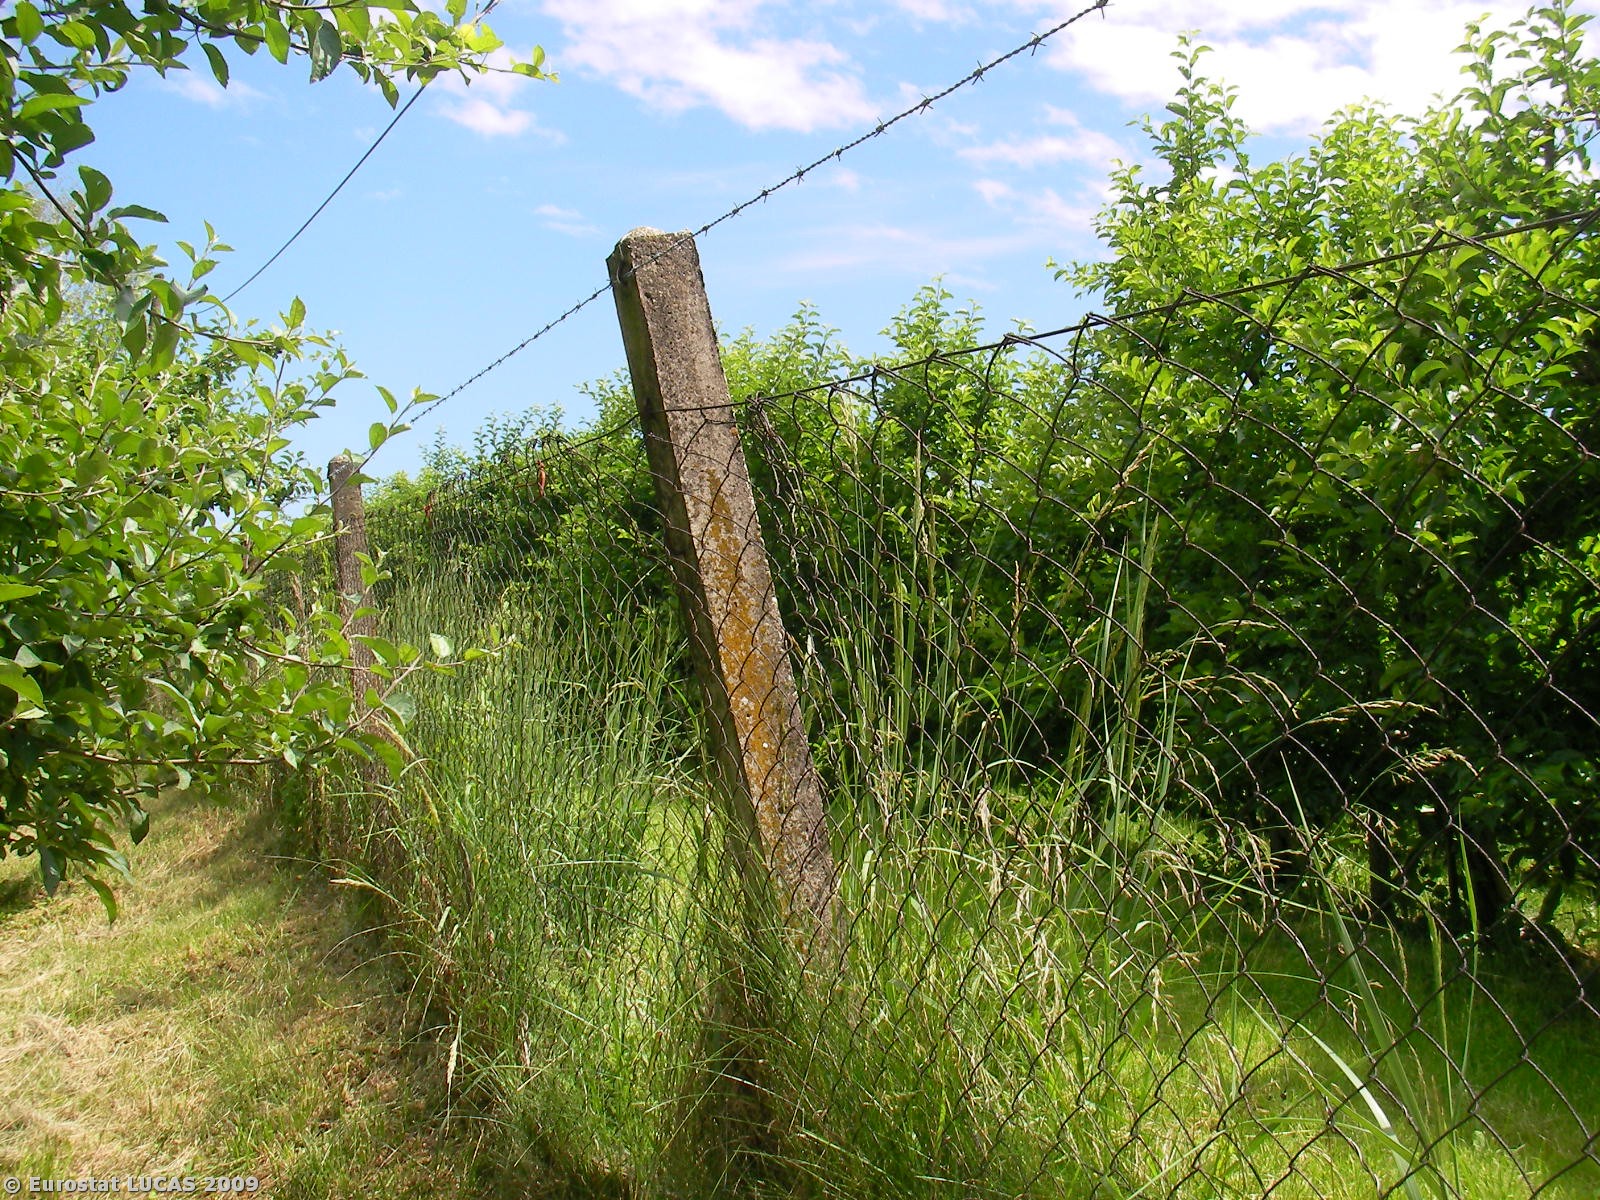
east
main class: Cropland
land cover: Apple fruit
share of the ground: 25 - 50 %
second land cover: Grassland with sparse tree/shrub cover
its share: > 75 %
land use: Agriculture (excluding fallow land and kitchen gardens)
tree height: > 5 m
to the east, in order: Apple fruit; Grassland with sparse tree/shrub cover; Fences; Abandoned hedges; Paved roads, cycling and walking lanes; Grass margins; Maize; Grassland without tree/shrub cover; Electric lines; Grassland without tree/shrub cover; Fences; Other fibre and oleaginous crops; Fences; Spontaneously vegetated surfaces; Mixed woodland; Fences; Mixed woodland
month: June
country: AT
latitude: 46.9468
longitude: 15.5573
